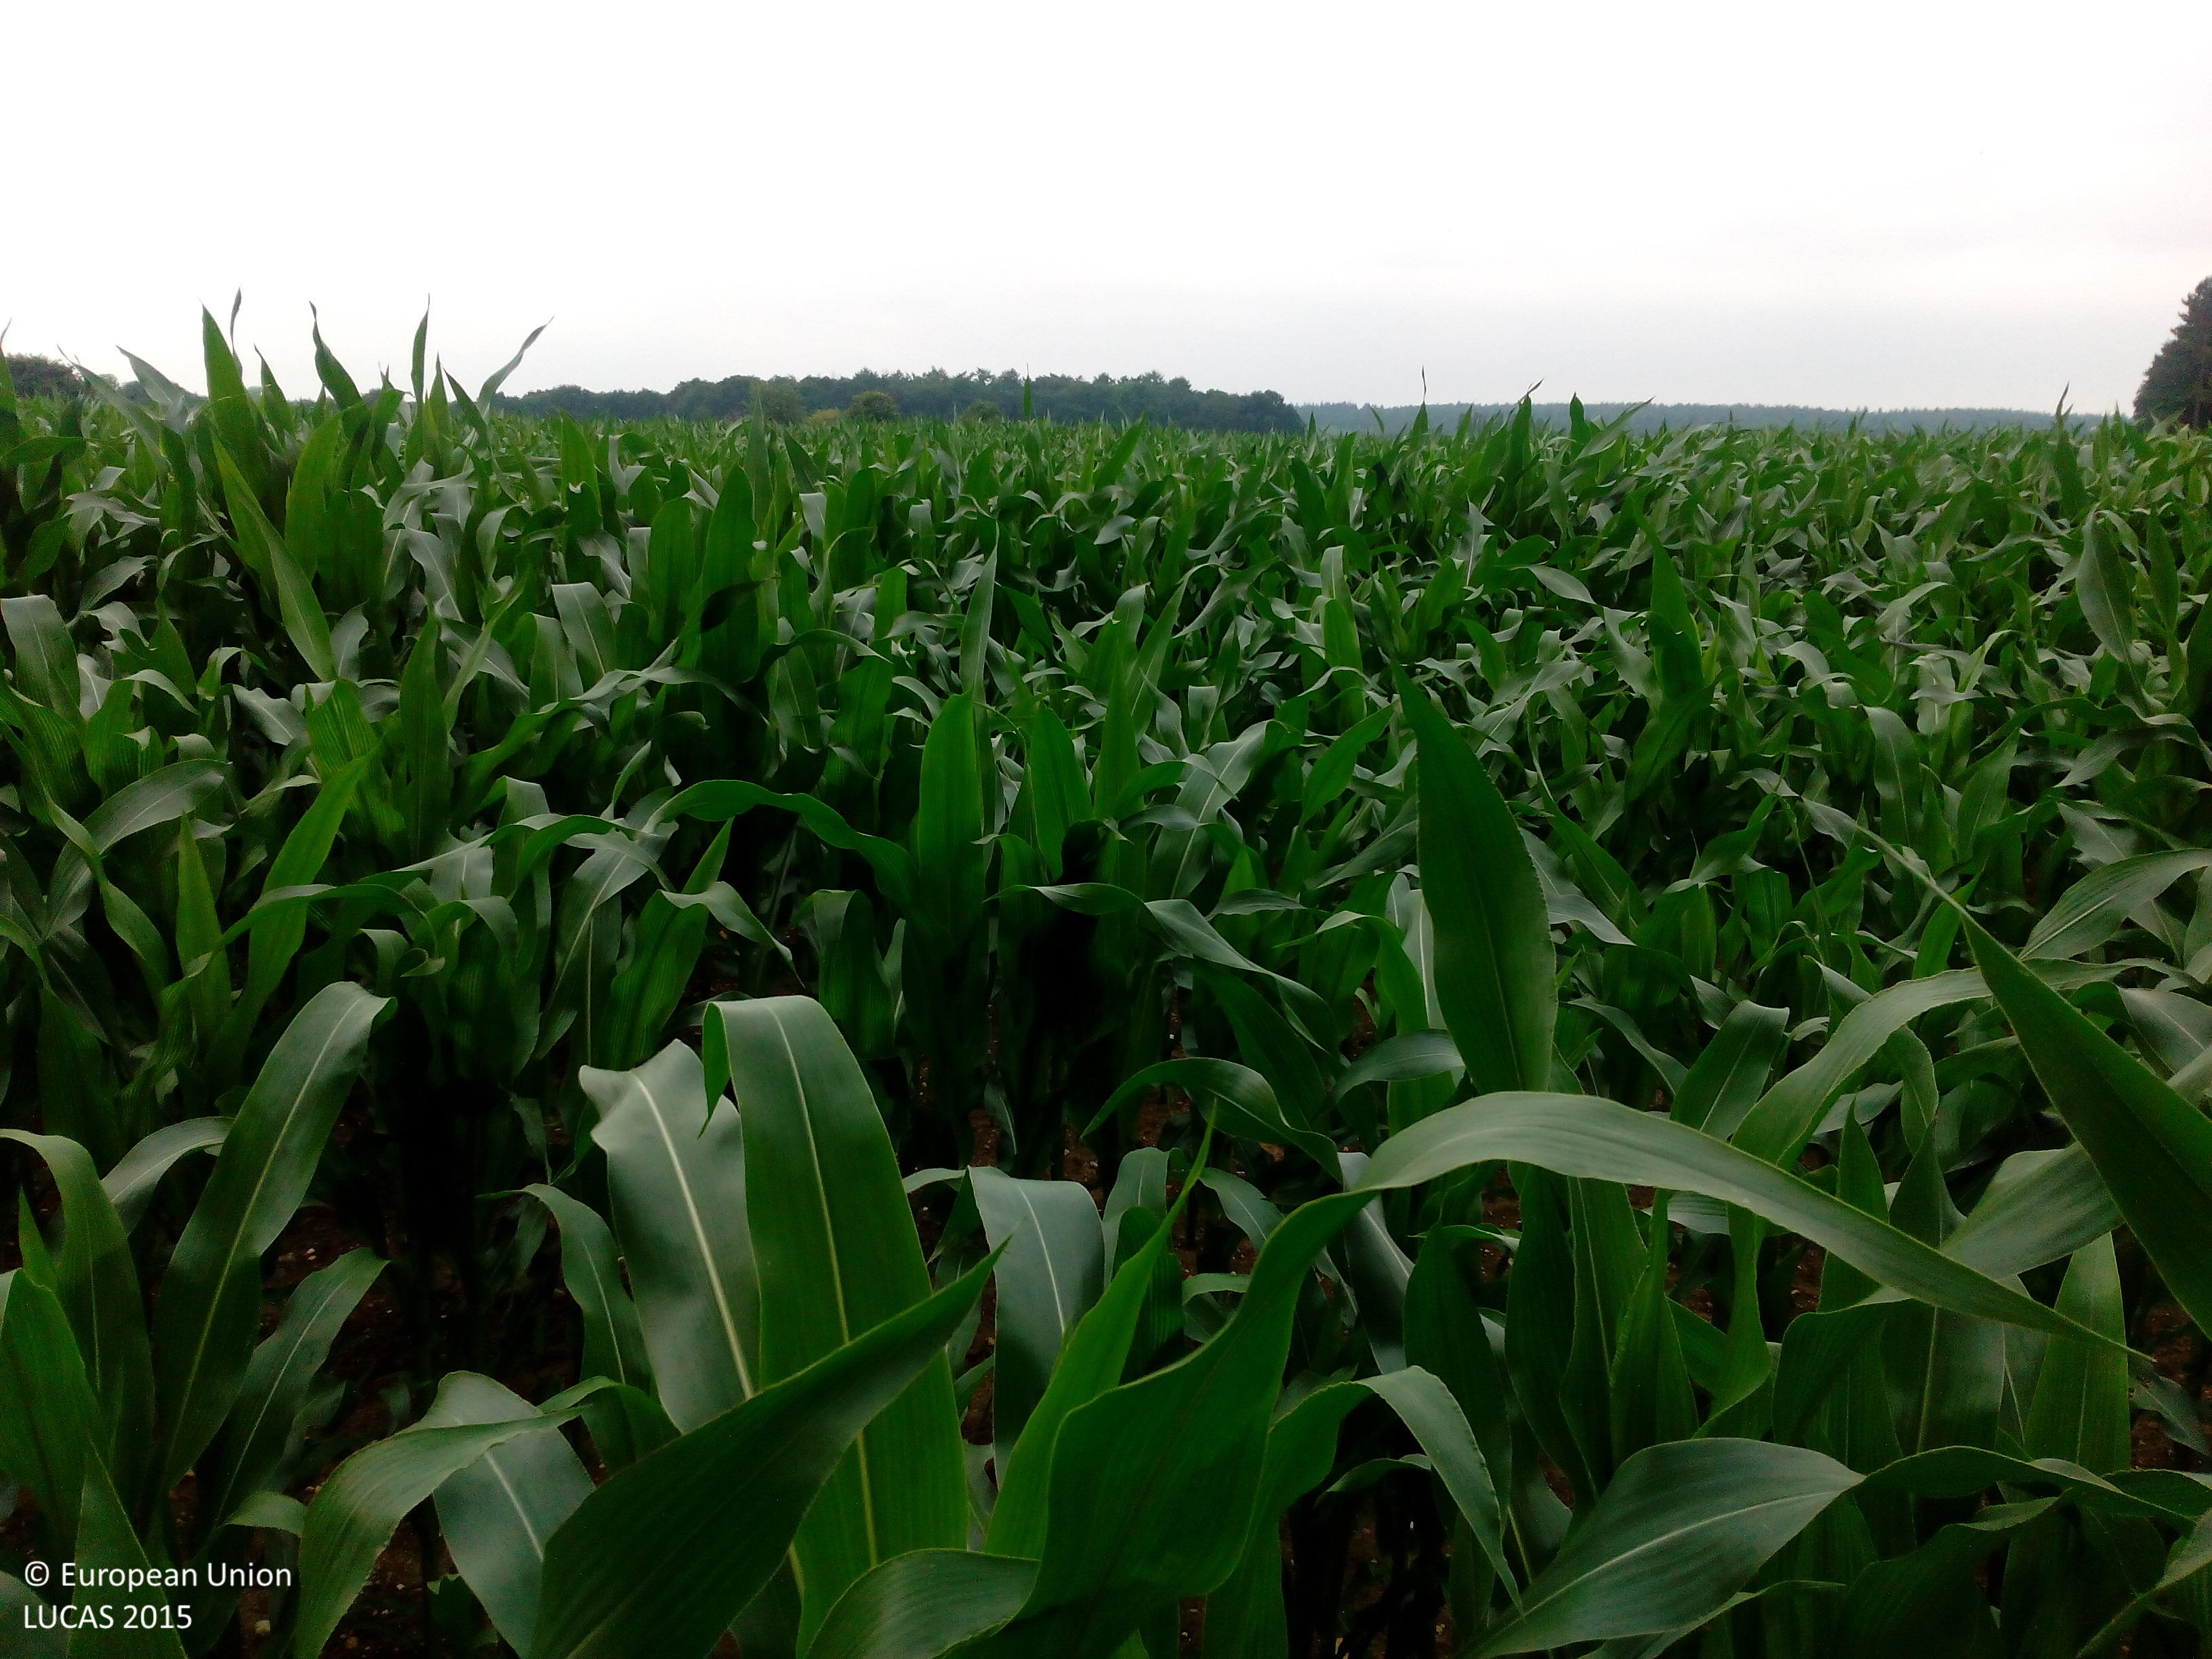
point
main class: Cropland
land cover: Maize
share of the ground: > 75 %
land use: Agriculture (excluding fallow land and kitchen gardens)
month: July
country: NL
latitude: 51.8860
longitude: 6.2364
